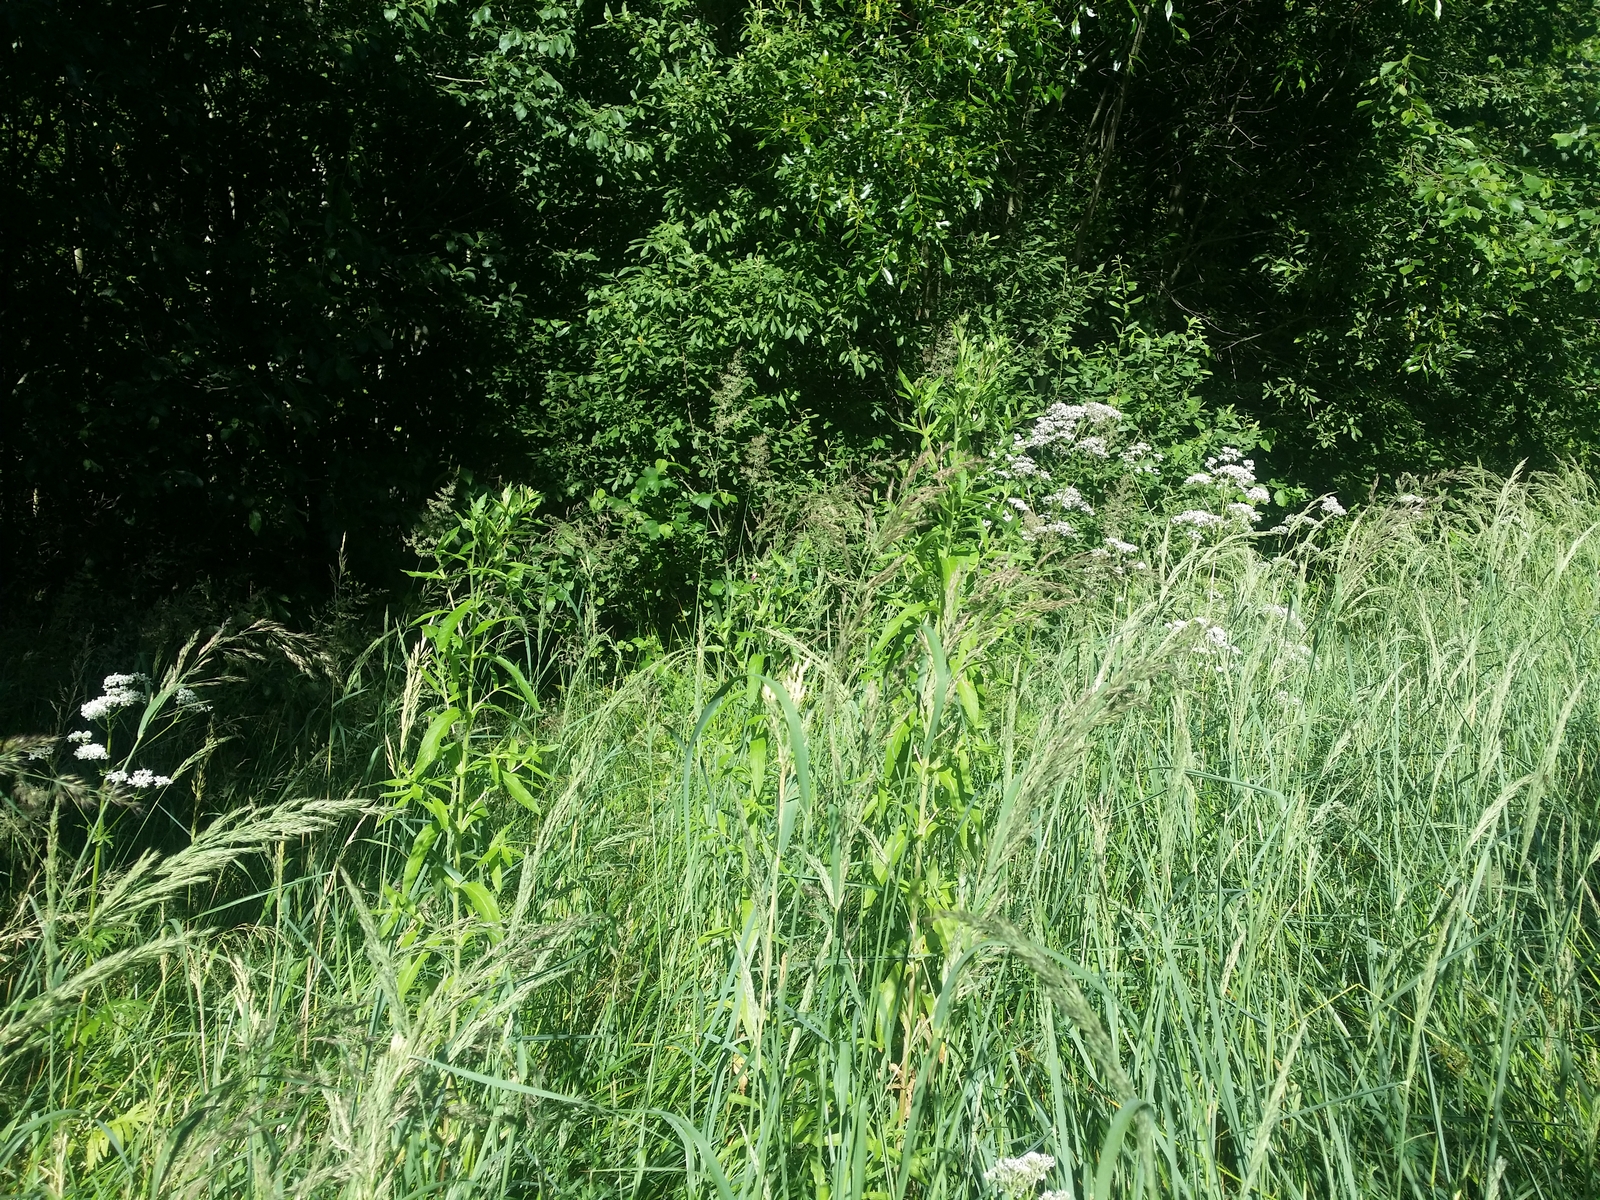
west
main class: Shrubland
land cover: Shrubland with sparse tree cover
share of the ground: 50 - 75 %
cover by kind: shrubs 65 %, herbaceous plants 30 %, broadleaved forest trees 5 %
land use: Semi-natural and natural areas not in use
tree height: < 5 m
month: July
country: LV
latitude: 57.1471
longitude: 27.2408
